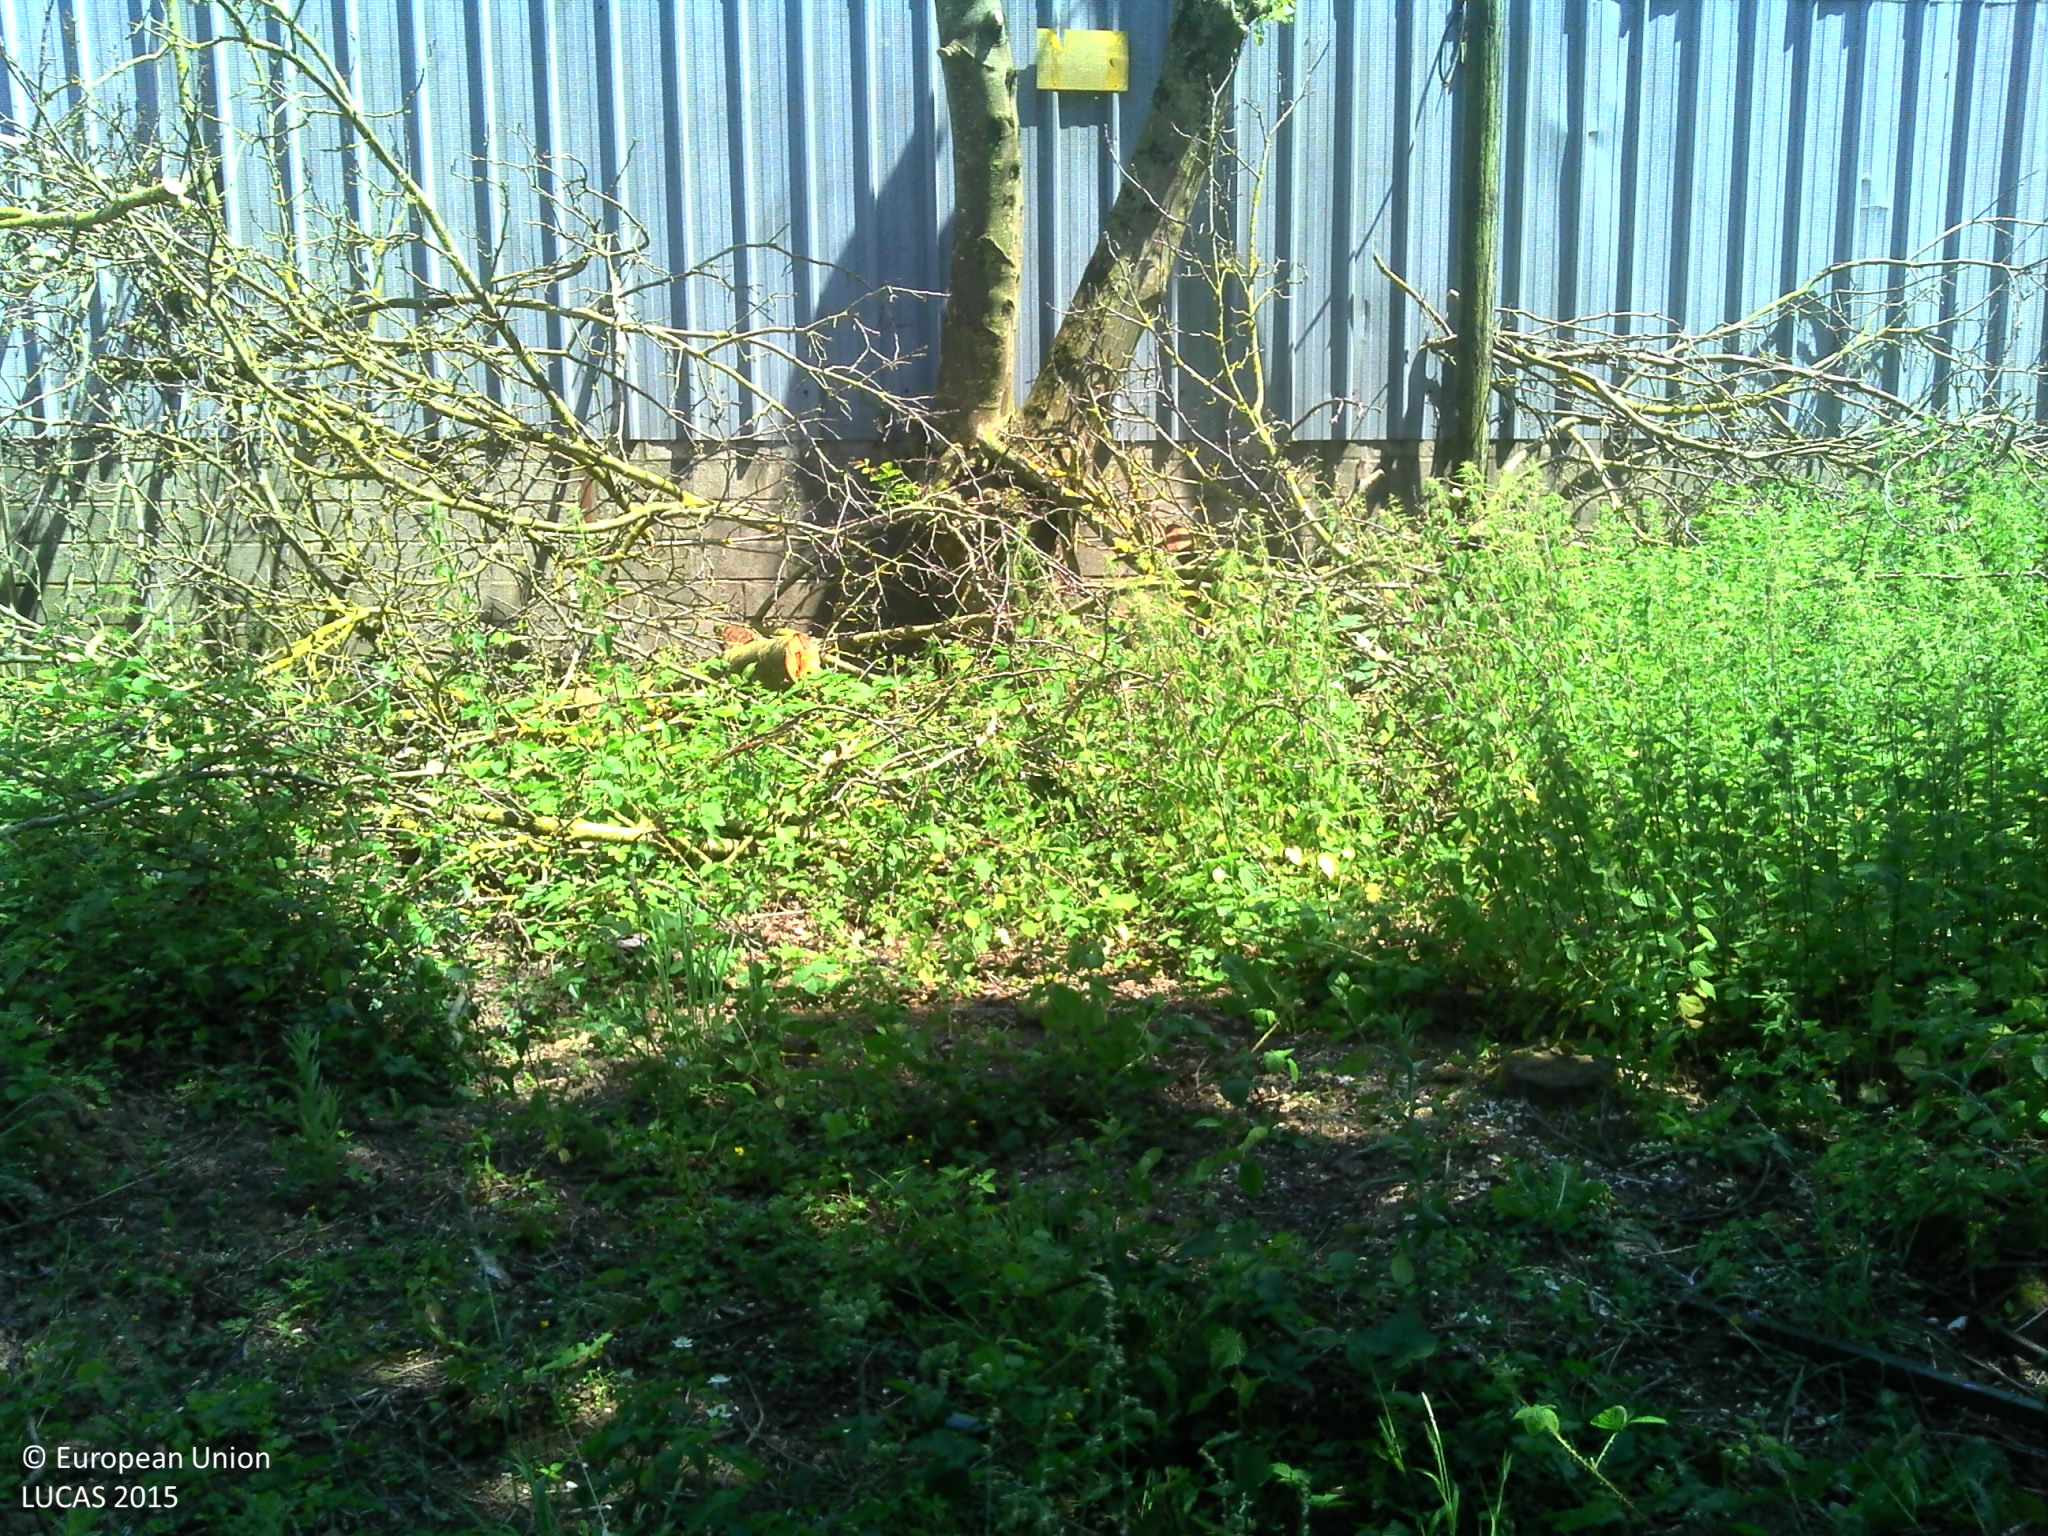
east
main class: Woodland
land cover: Broadleaved woodland
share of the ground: > 75 %
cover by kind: broadleaved forest trees 100 %
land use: Semi-natural and natural areas not in use
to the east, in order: Broadleaved woodland; Artificial constructions in urban areas; Abandoned hedges; Grass margins; Paved roads, cycling and walking lanes; Grass margins; Managed hedges; Maize; Electric lines; Maize; Common wheat; Broadleaved woodland; Triticale
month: June
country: FR
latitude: 49.6310
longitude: 4.0275
